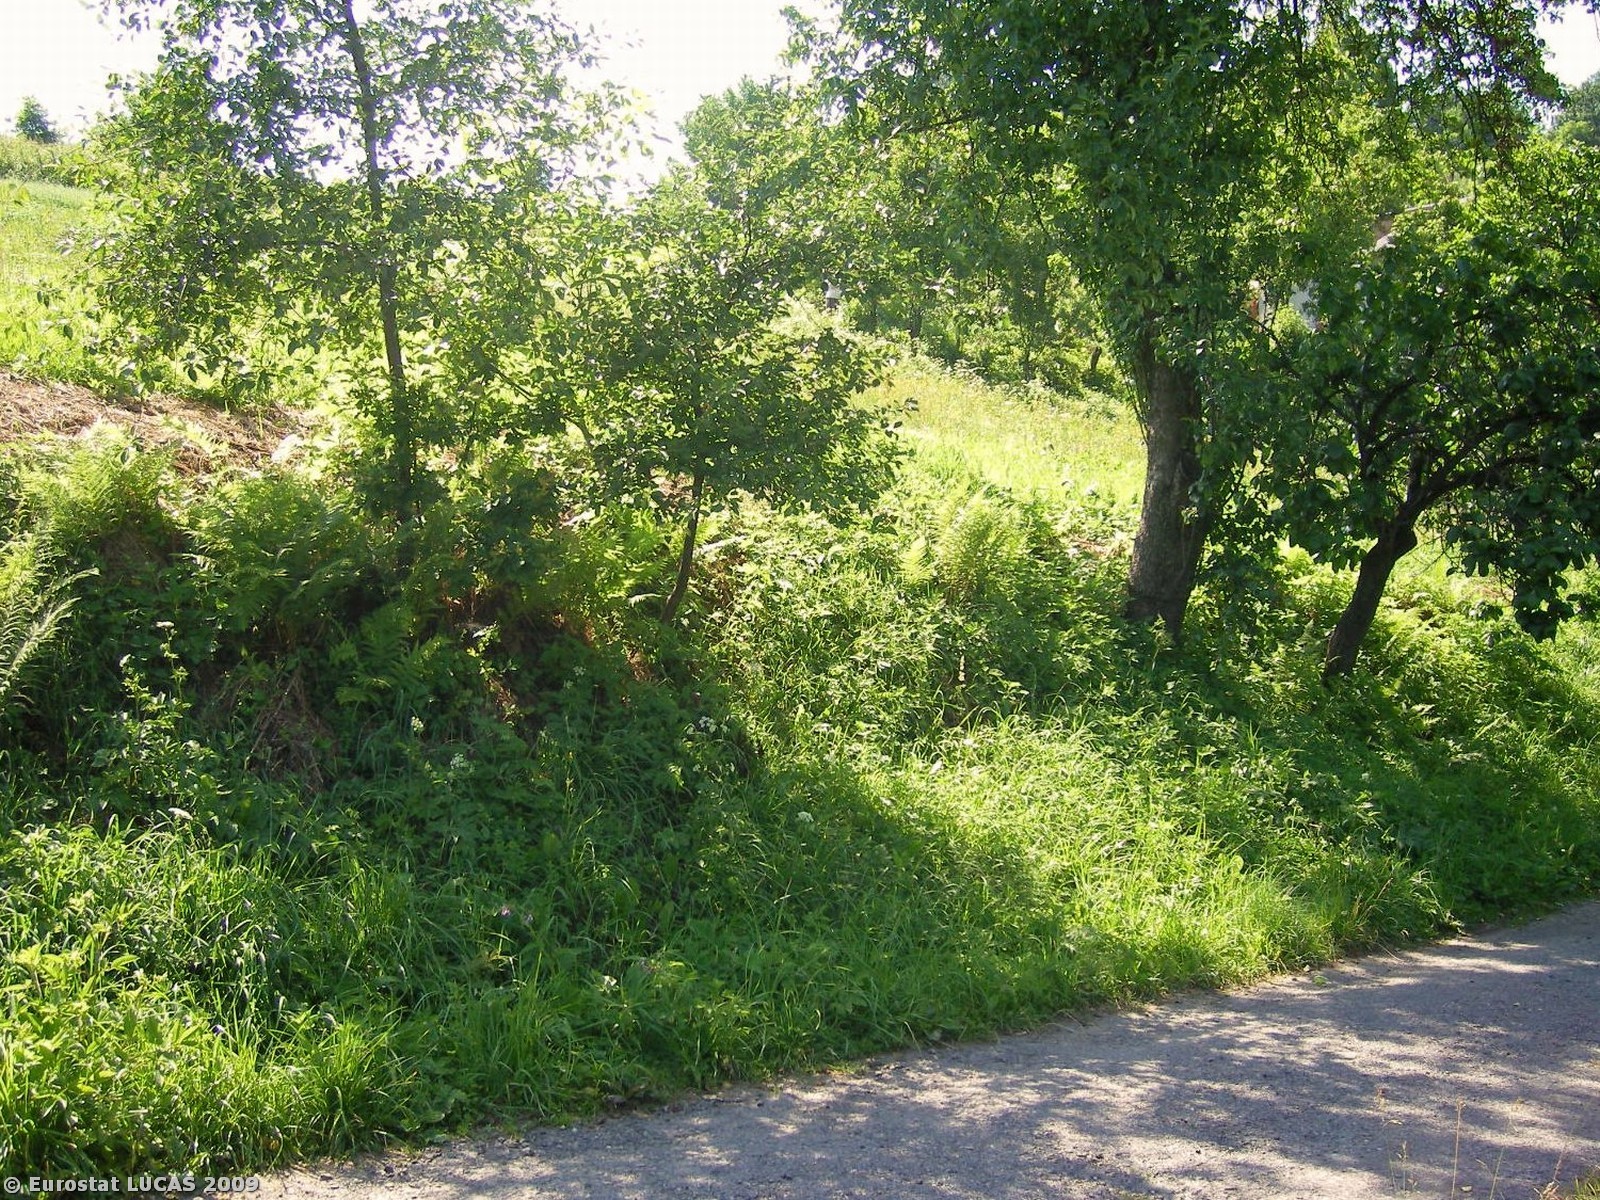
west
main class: Grassland
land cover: Grassland without tree/shrub cover
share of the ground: > 75 %
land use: Road transport
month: September
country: PL
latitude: 49.8428
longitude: 19.6933
